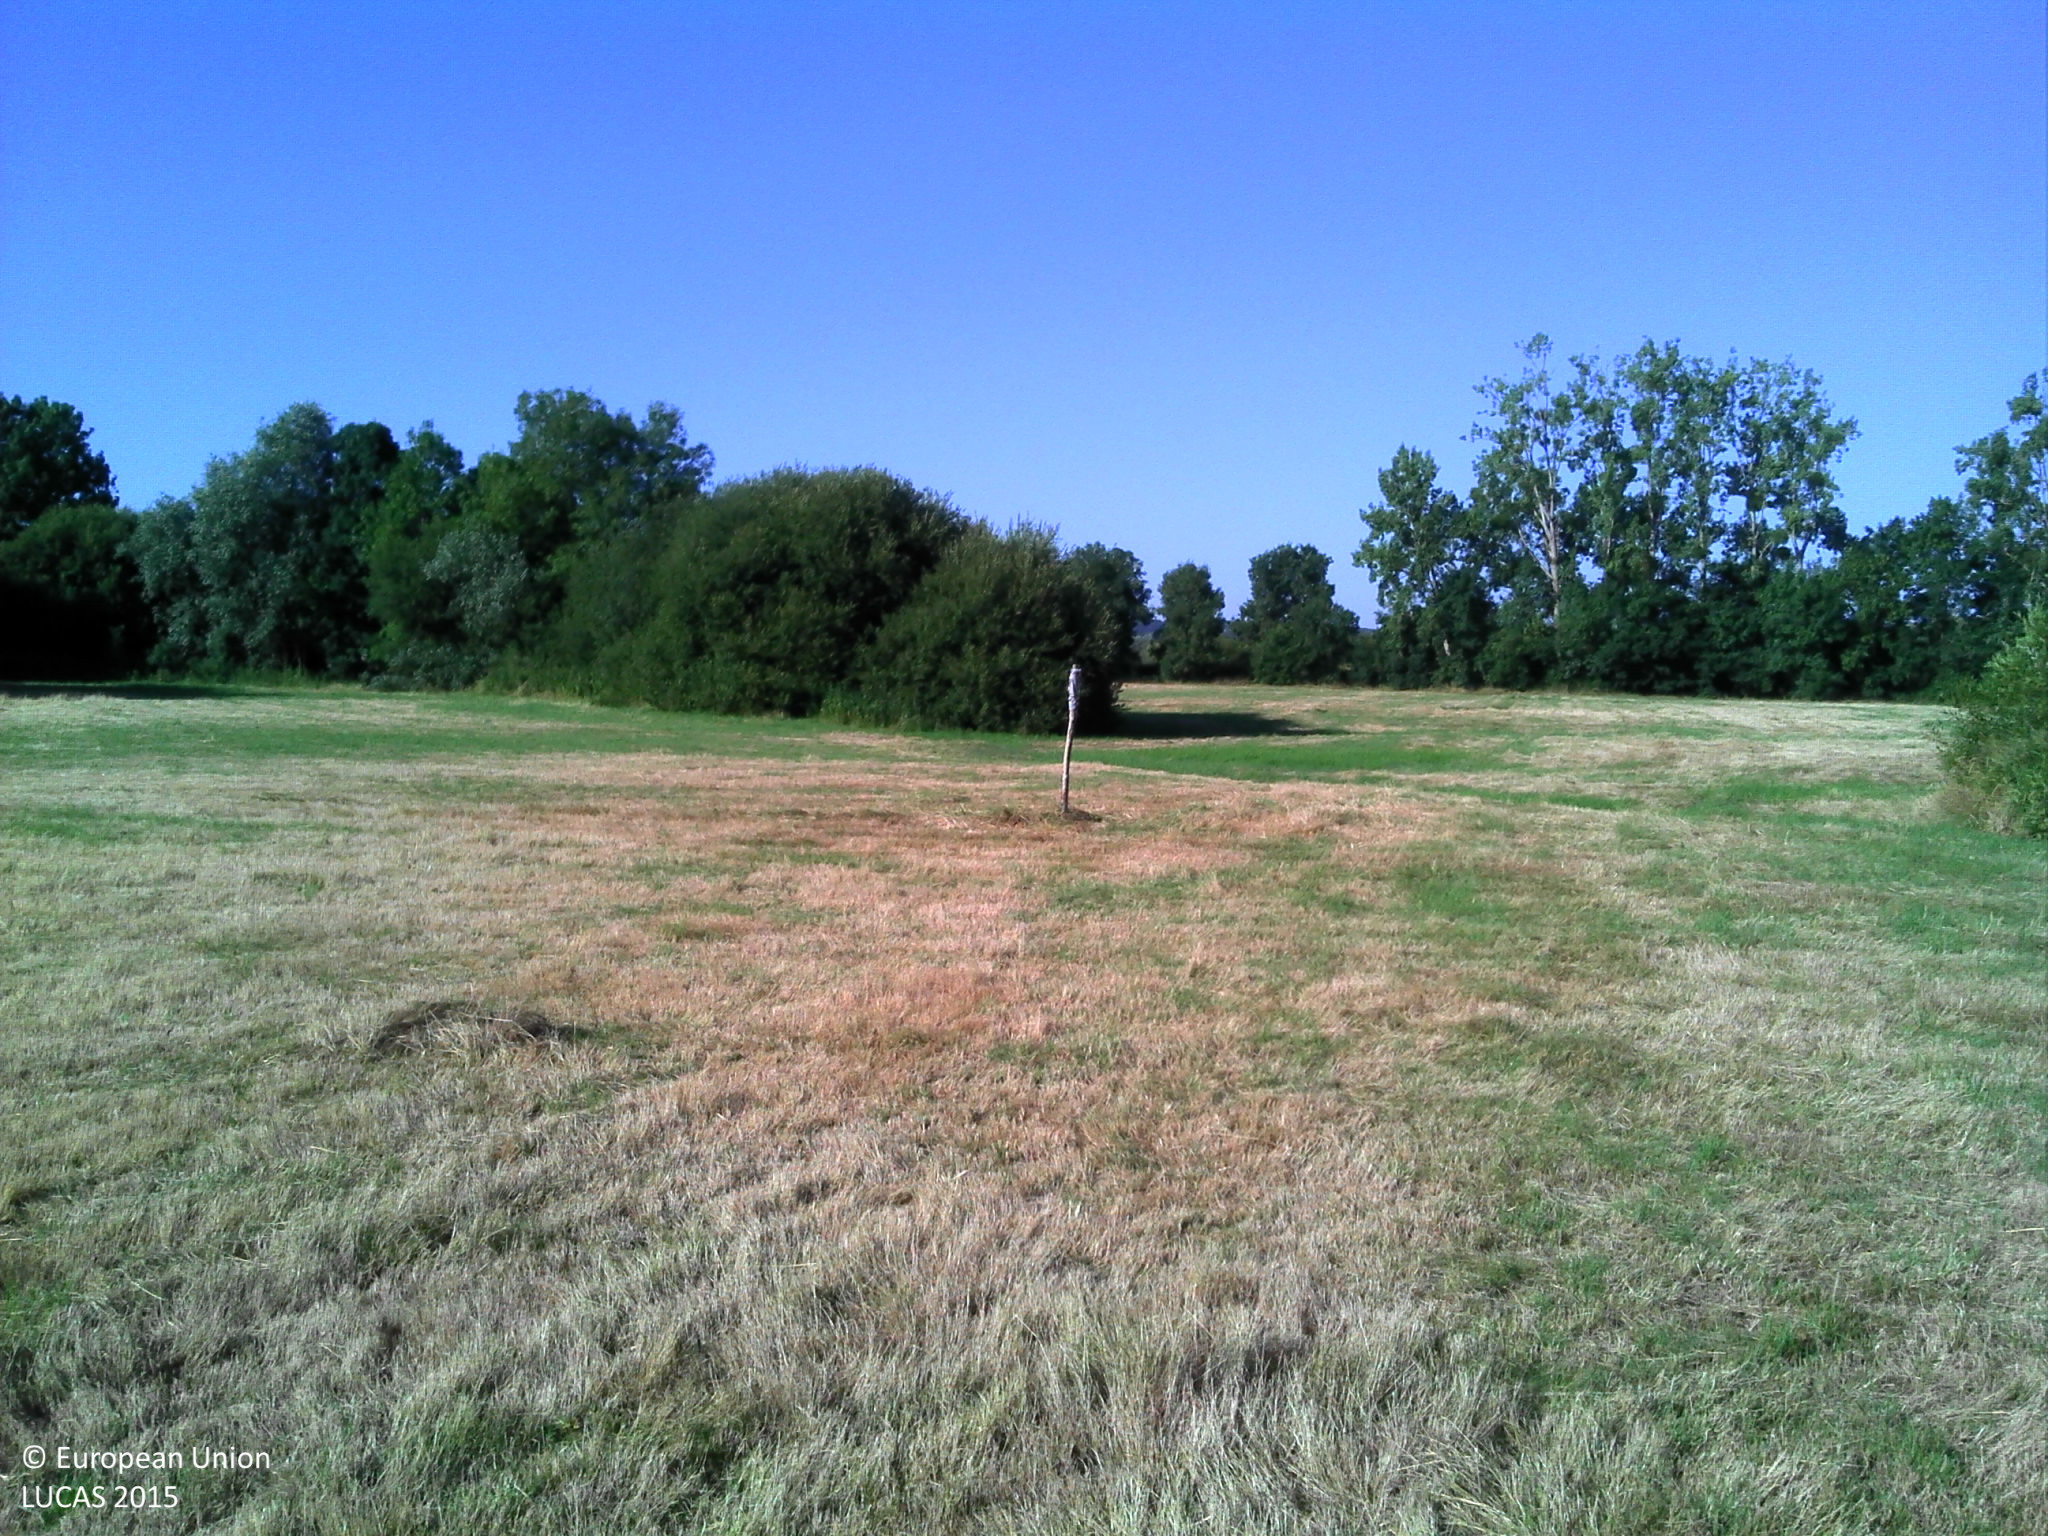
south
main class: Cropland
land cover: Temporary grasslands
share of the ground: > 75 %
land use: Agriculture (excluding fallow land and kitchen gardens)
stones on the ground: < 10 %
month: July
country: FR
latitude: 47.6776
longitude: -1.9715
